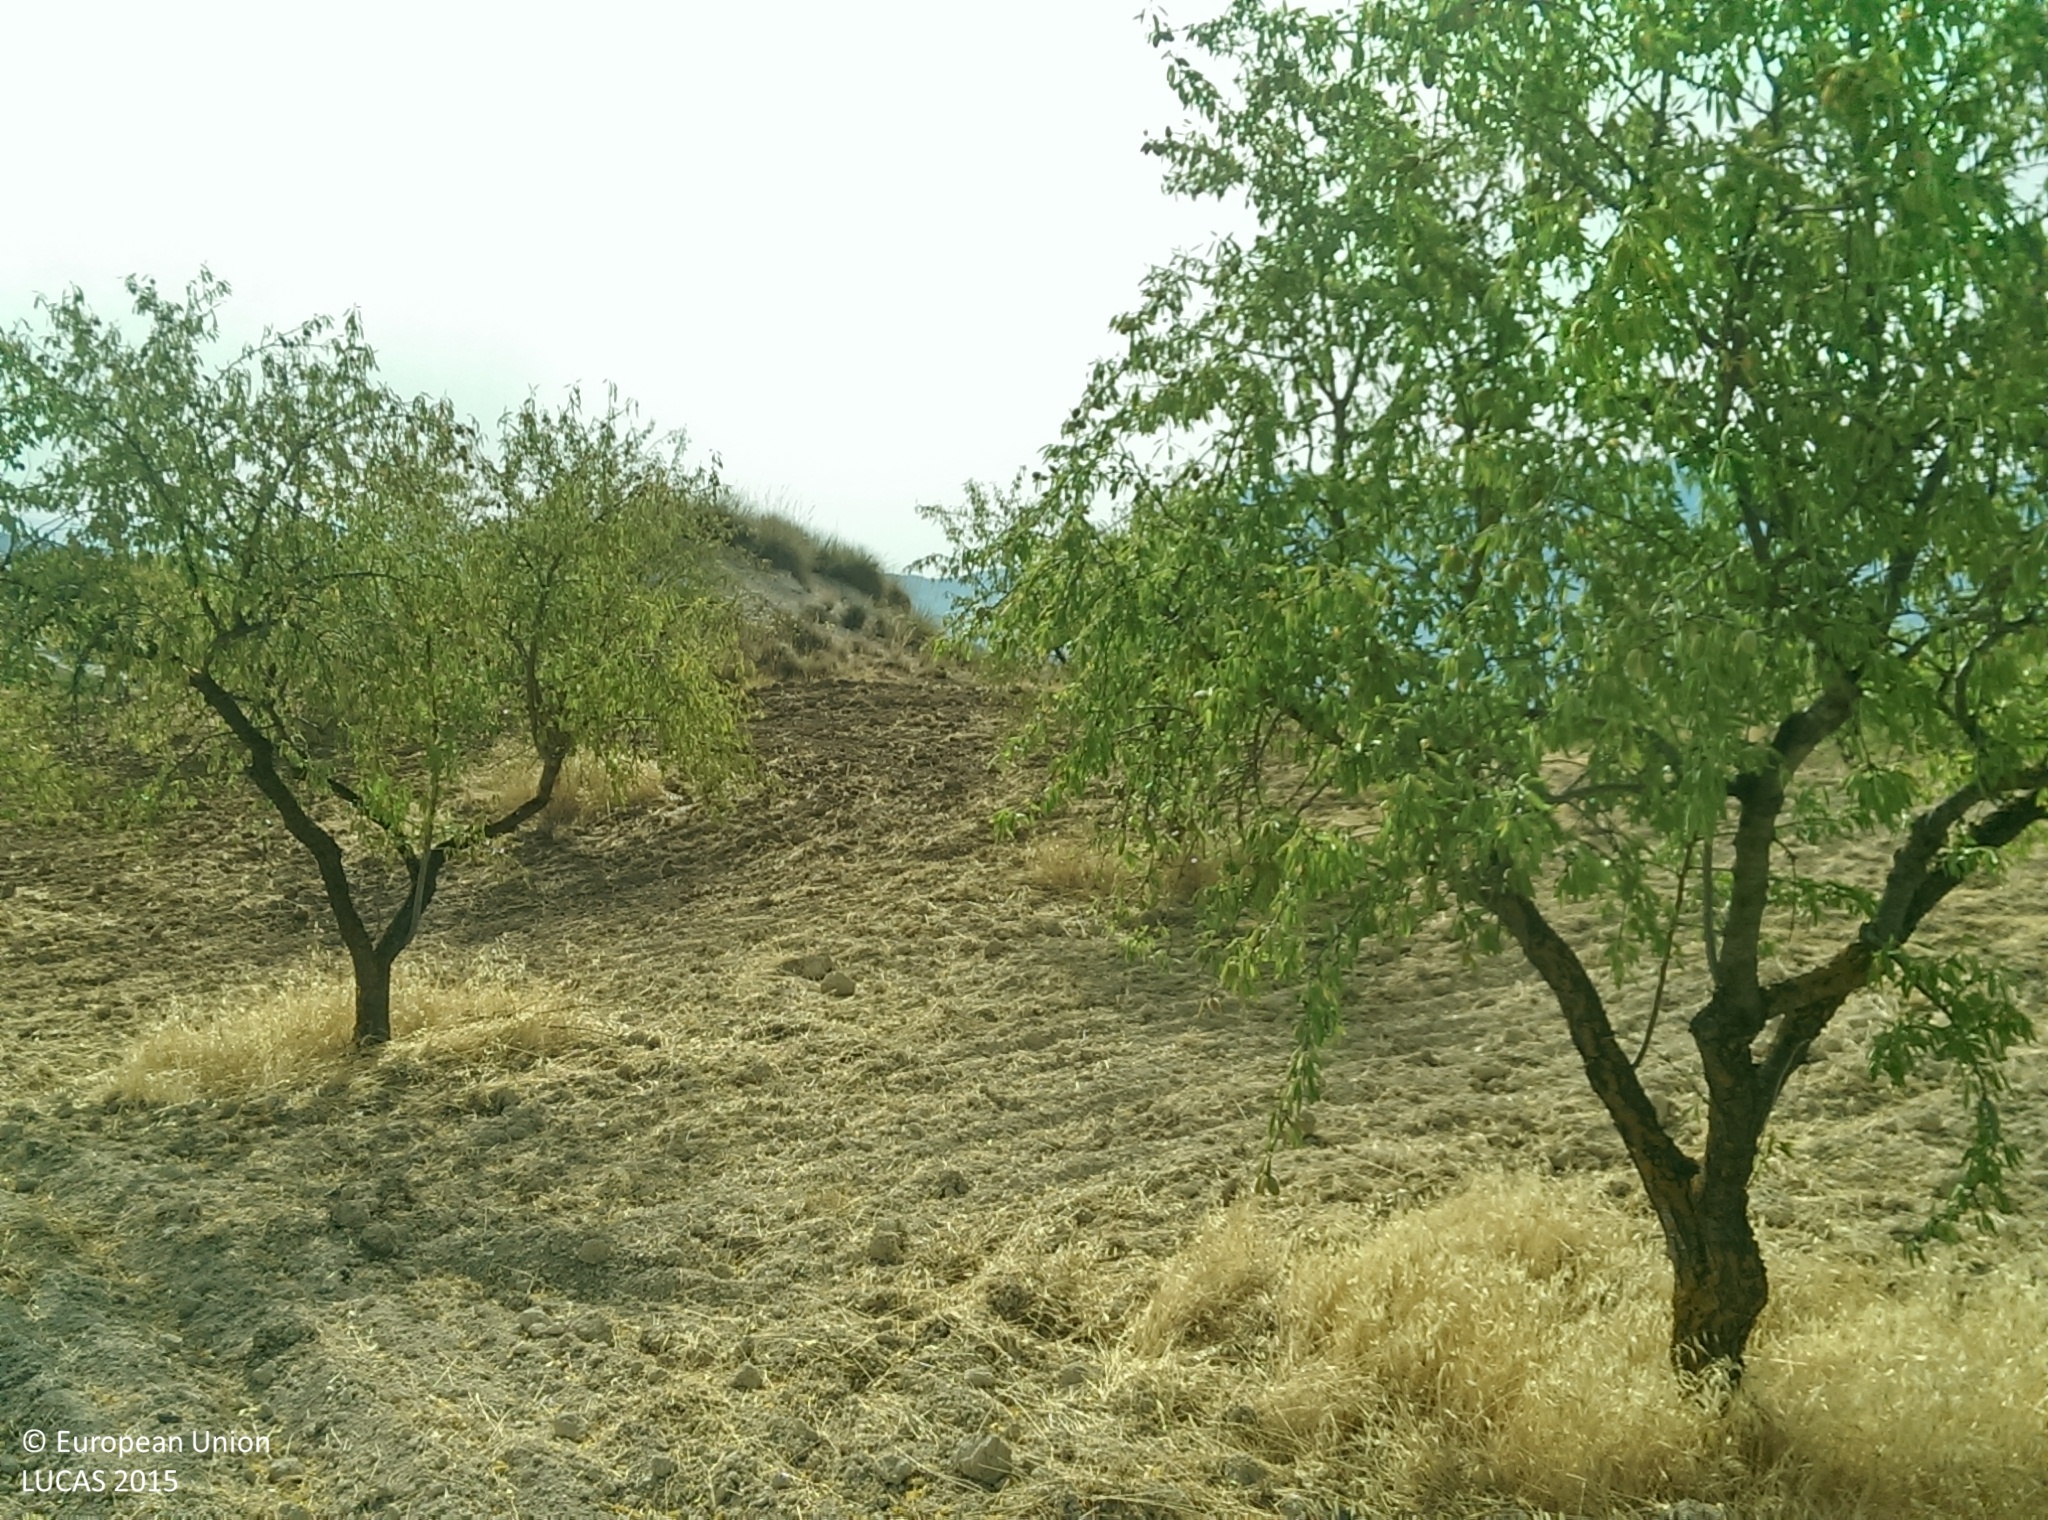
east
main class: Cropland
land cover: Nuts trees
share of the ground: 25 - 50 %
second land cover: Other bare soil
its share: > 75 %
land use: Agriculture (excluding fallow land and kitchen gardens)
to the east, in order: Nuts trees; Other bare soil; Shrubland without tree cover; Nuts trees; Shrubland without tree cover; Nuts trees; Pine dominated coniferous woodland
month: July
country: ES
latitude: 37.5998
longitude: -2.8906
